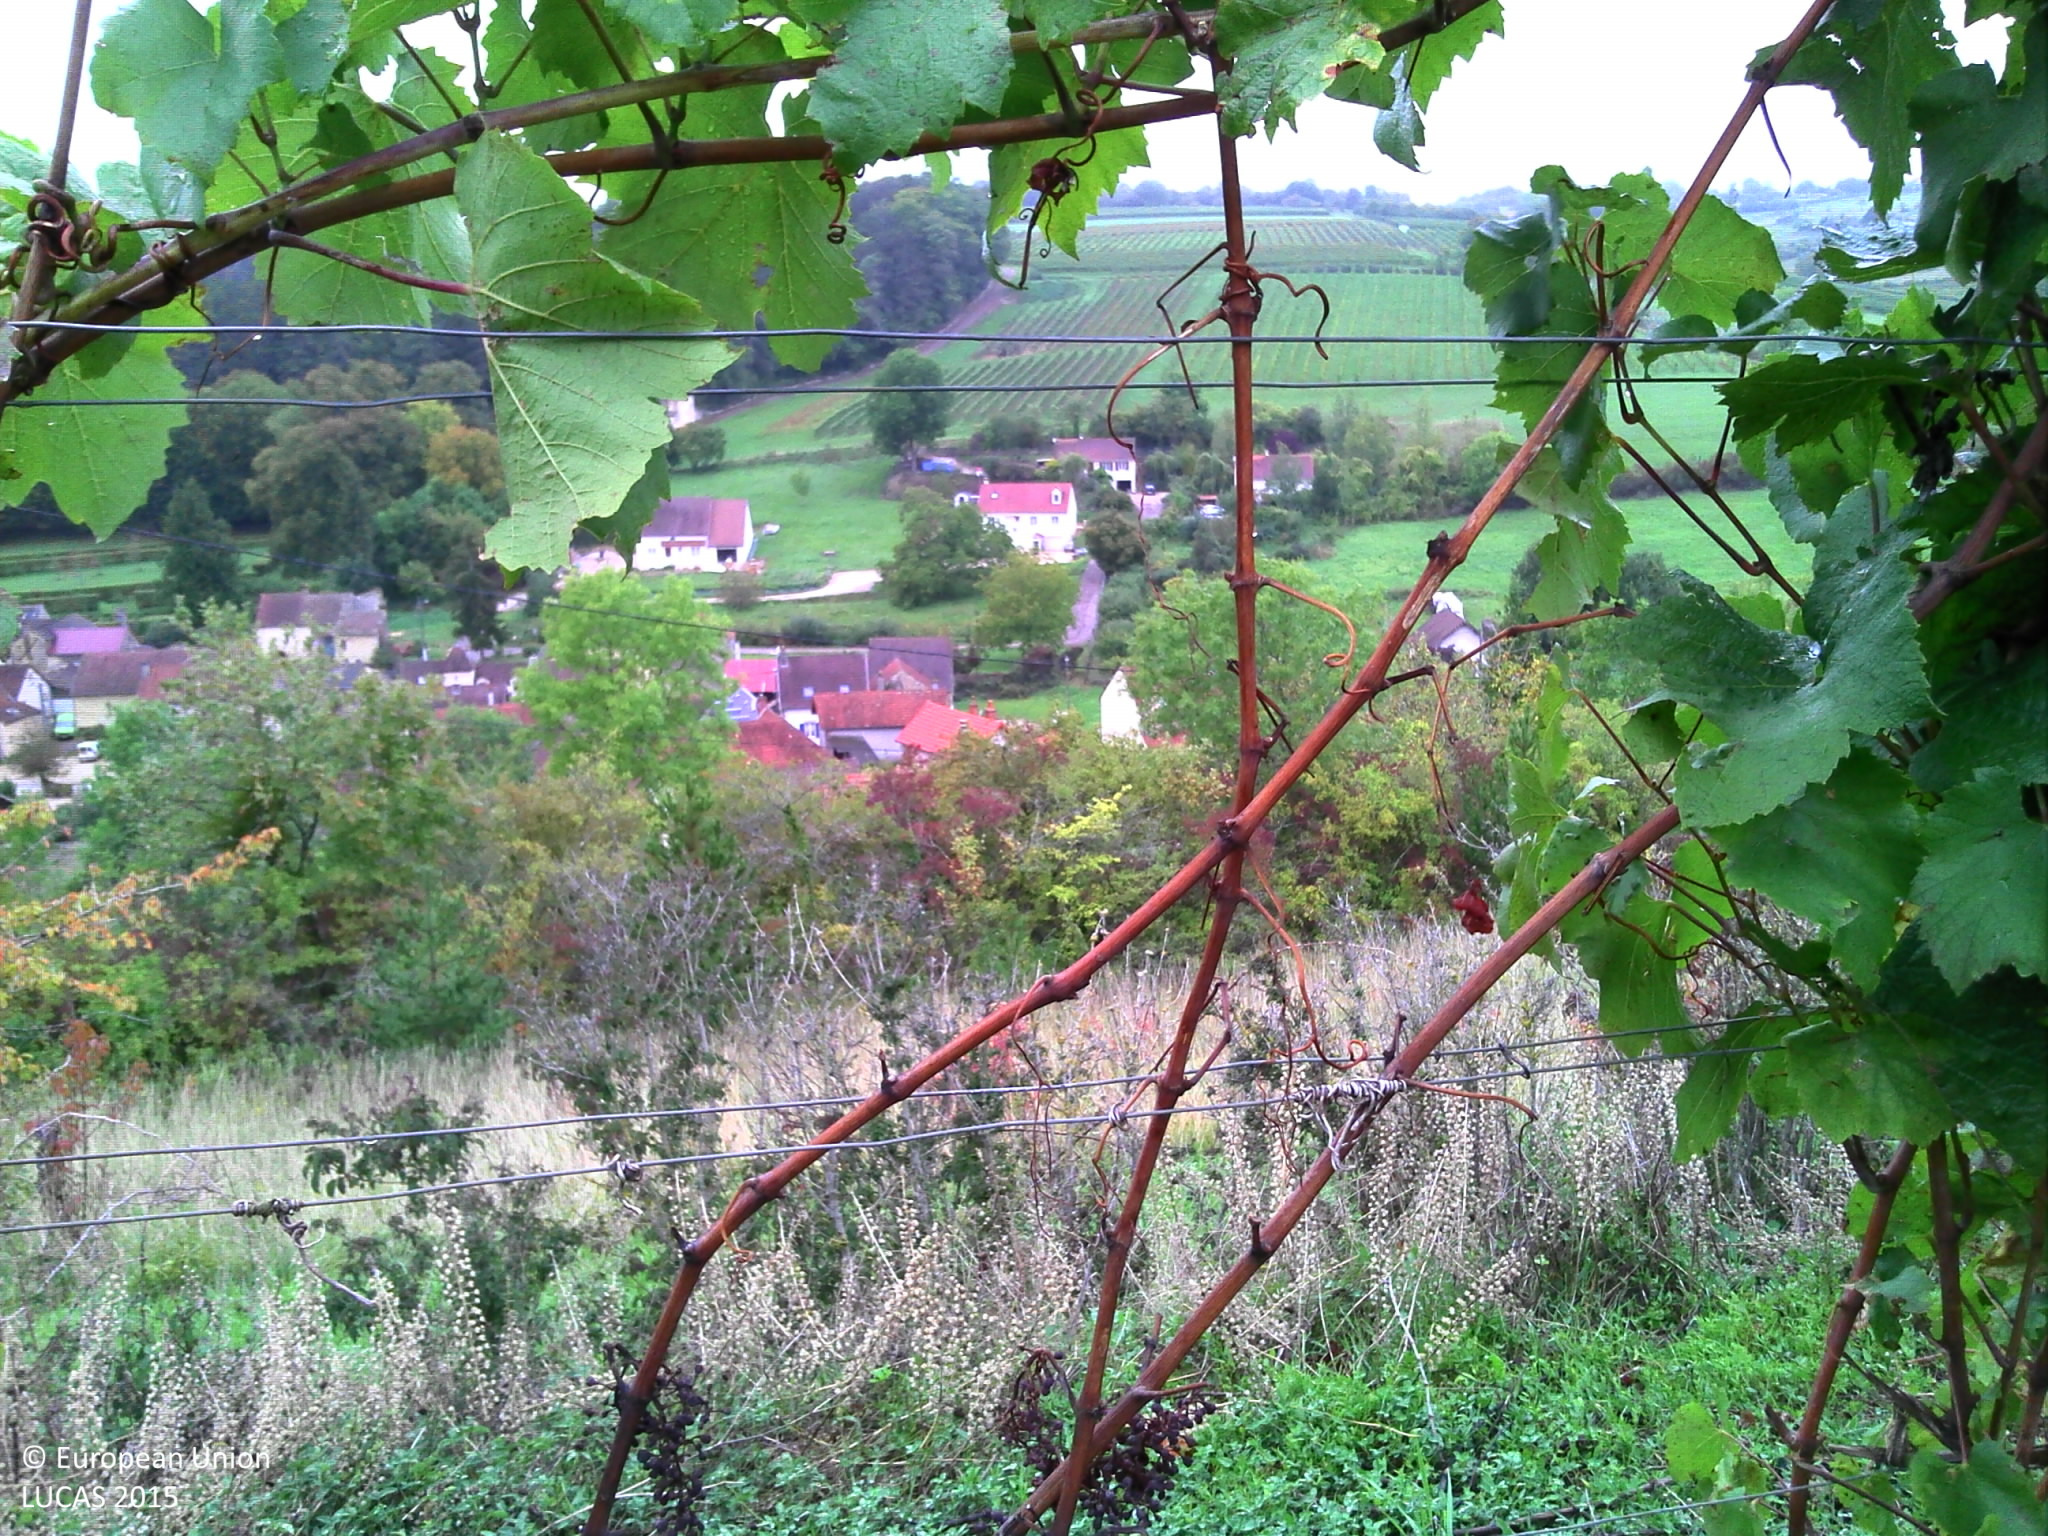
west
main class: Cropland
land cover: Vineyards
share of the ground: 10 - 25 %
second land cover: Grassland without tree/shrub cover
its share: > 75 %
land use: Agriculture (excluding fallow land and kitchen gardens)
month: September
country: FR
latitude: 47.1112
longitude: 4.8478
